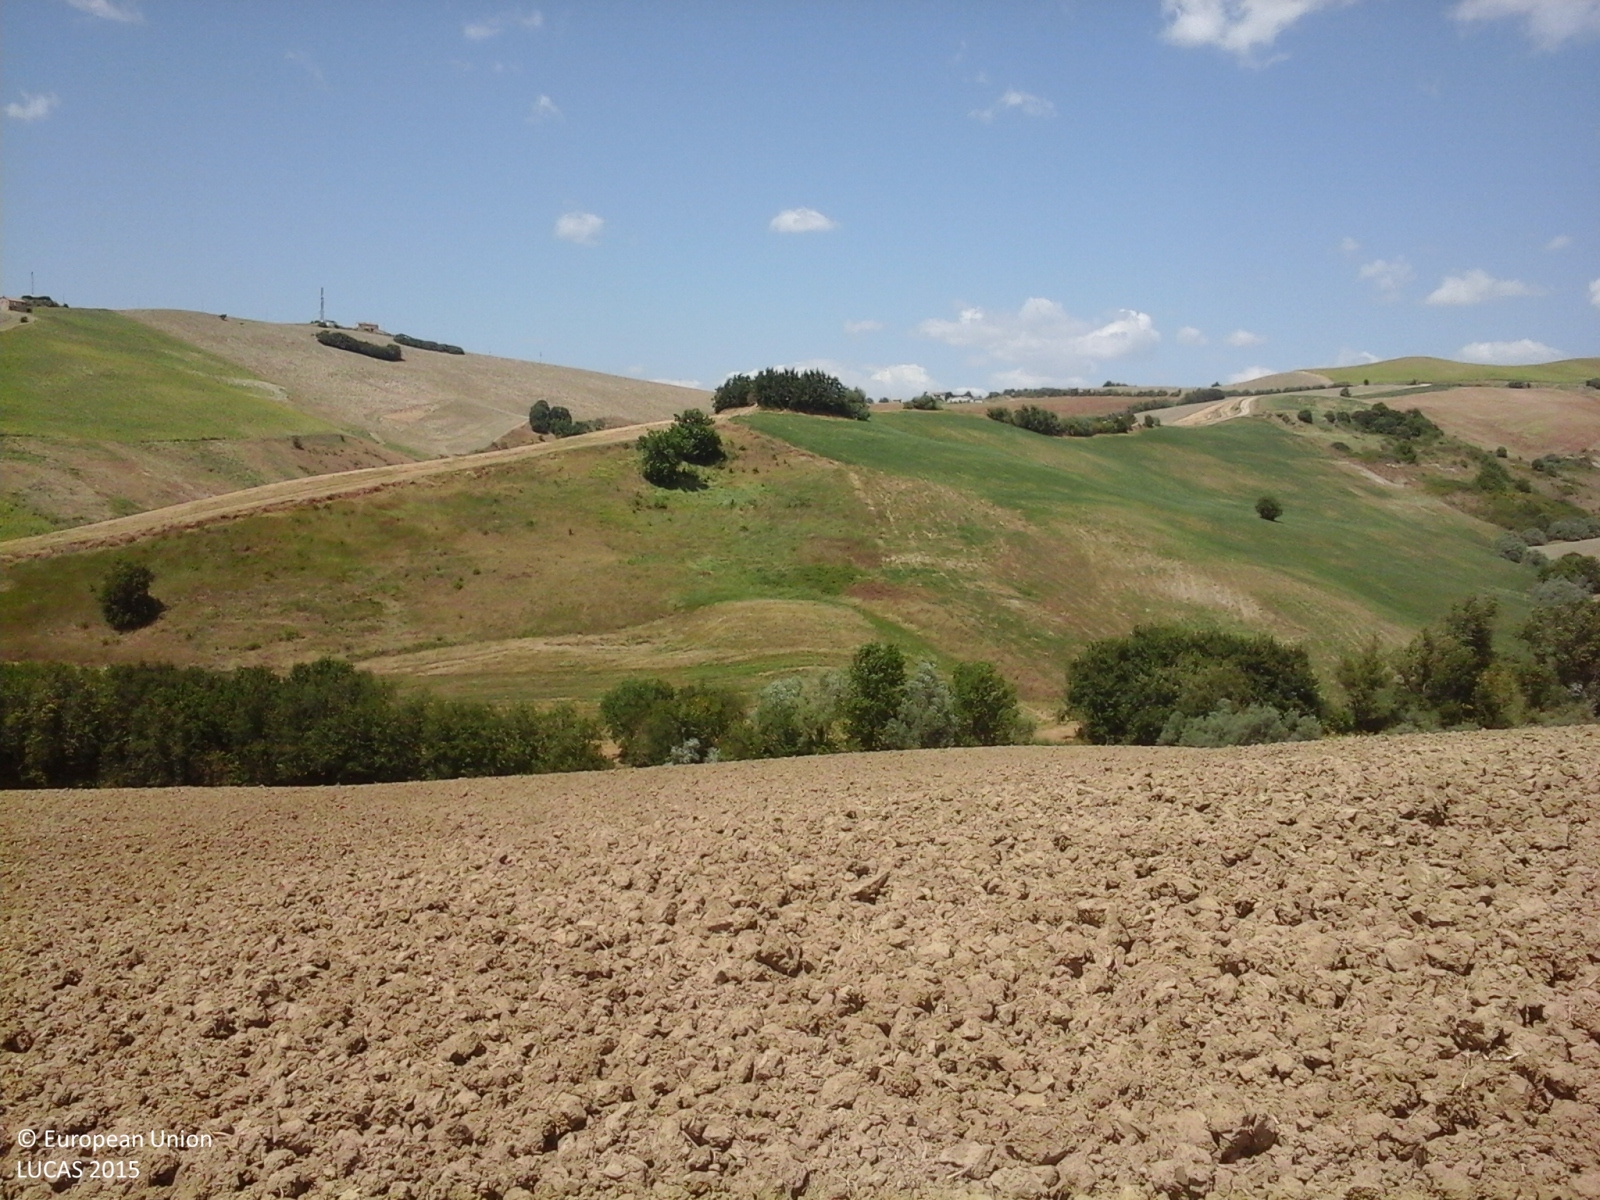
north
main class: Cropland
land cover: Durum wheat
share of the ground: > 75 %
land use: Agriculture (excluding fallow land and kitchen gardens)
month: July
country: IT
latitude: 43.2342
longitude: 13.2545
